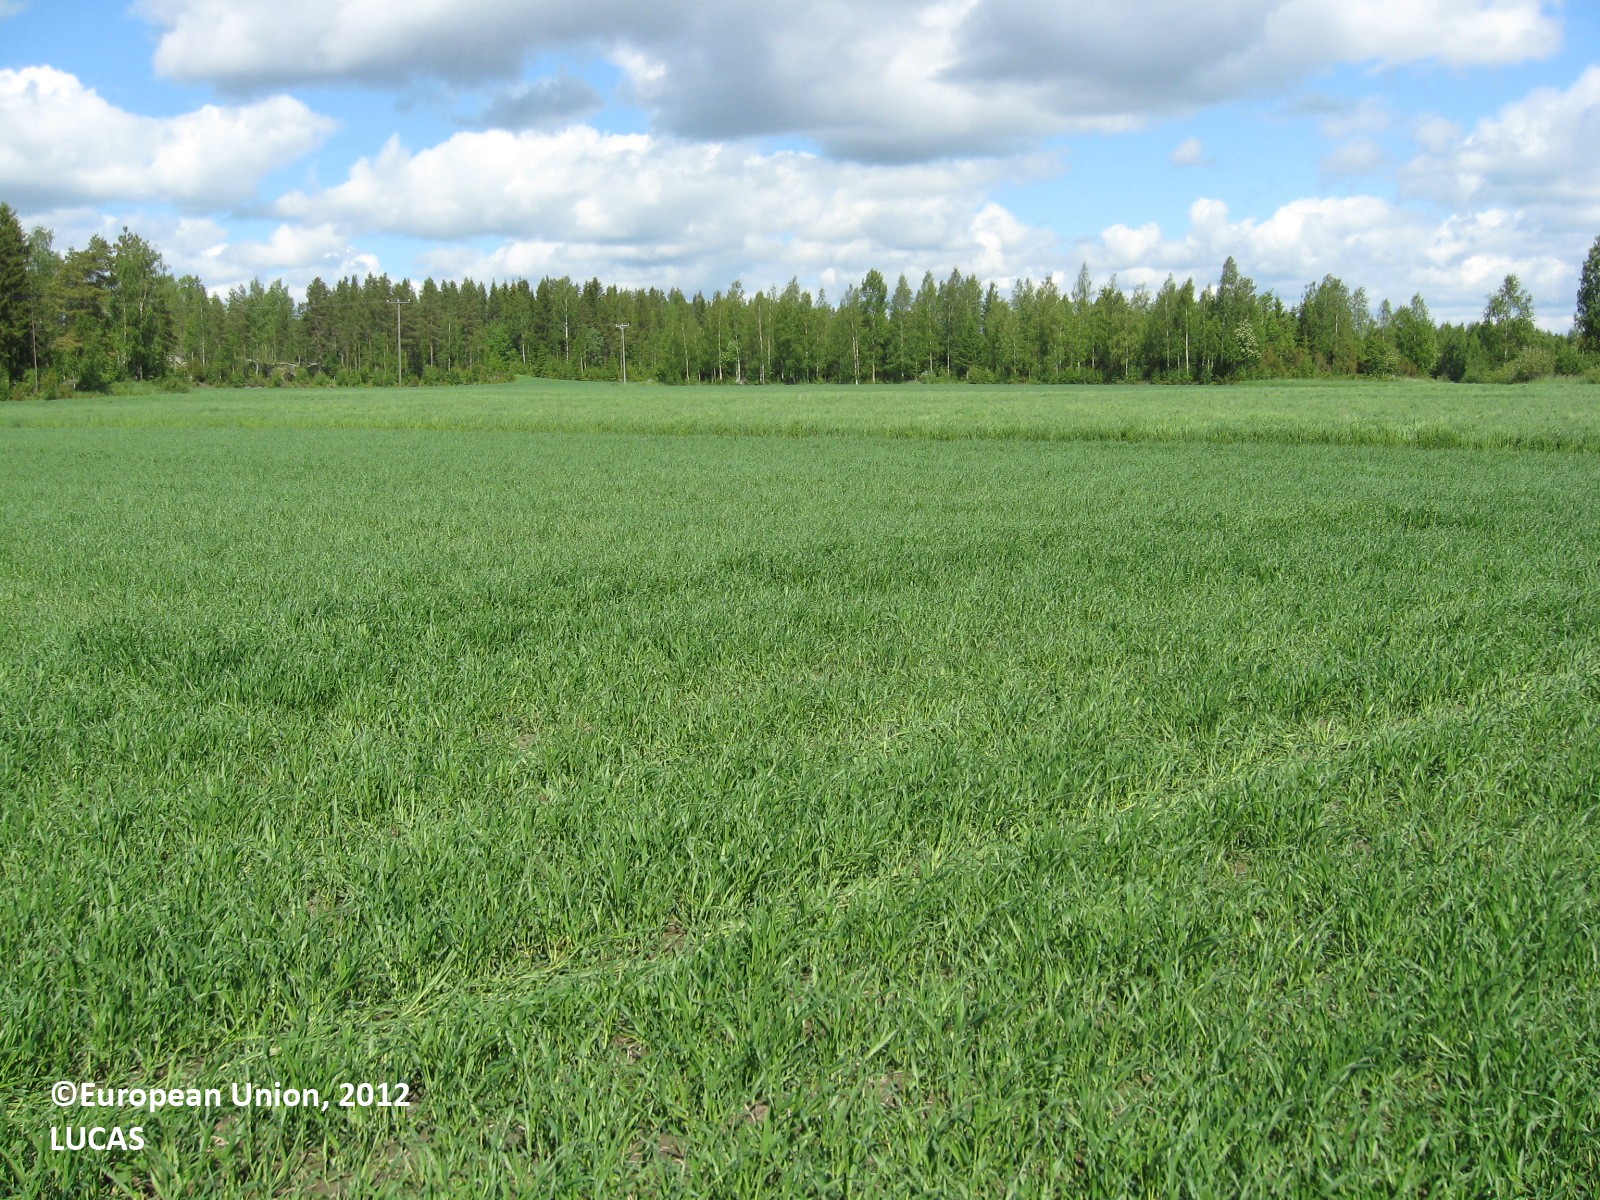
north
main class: Cropland
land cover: Barley
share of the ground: > 75 %
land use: Agriculture (excluding fallow land and kitchen gardens)
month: June
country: FI
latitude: 63.0467
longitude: 22.6501
